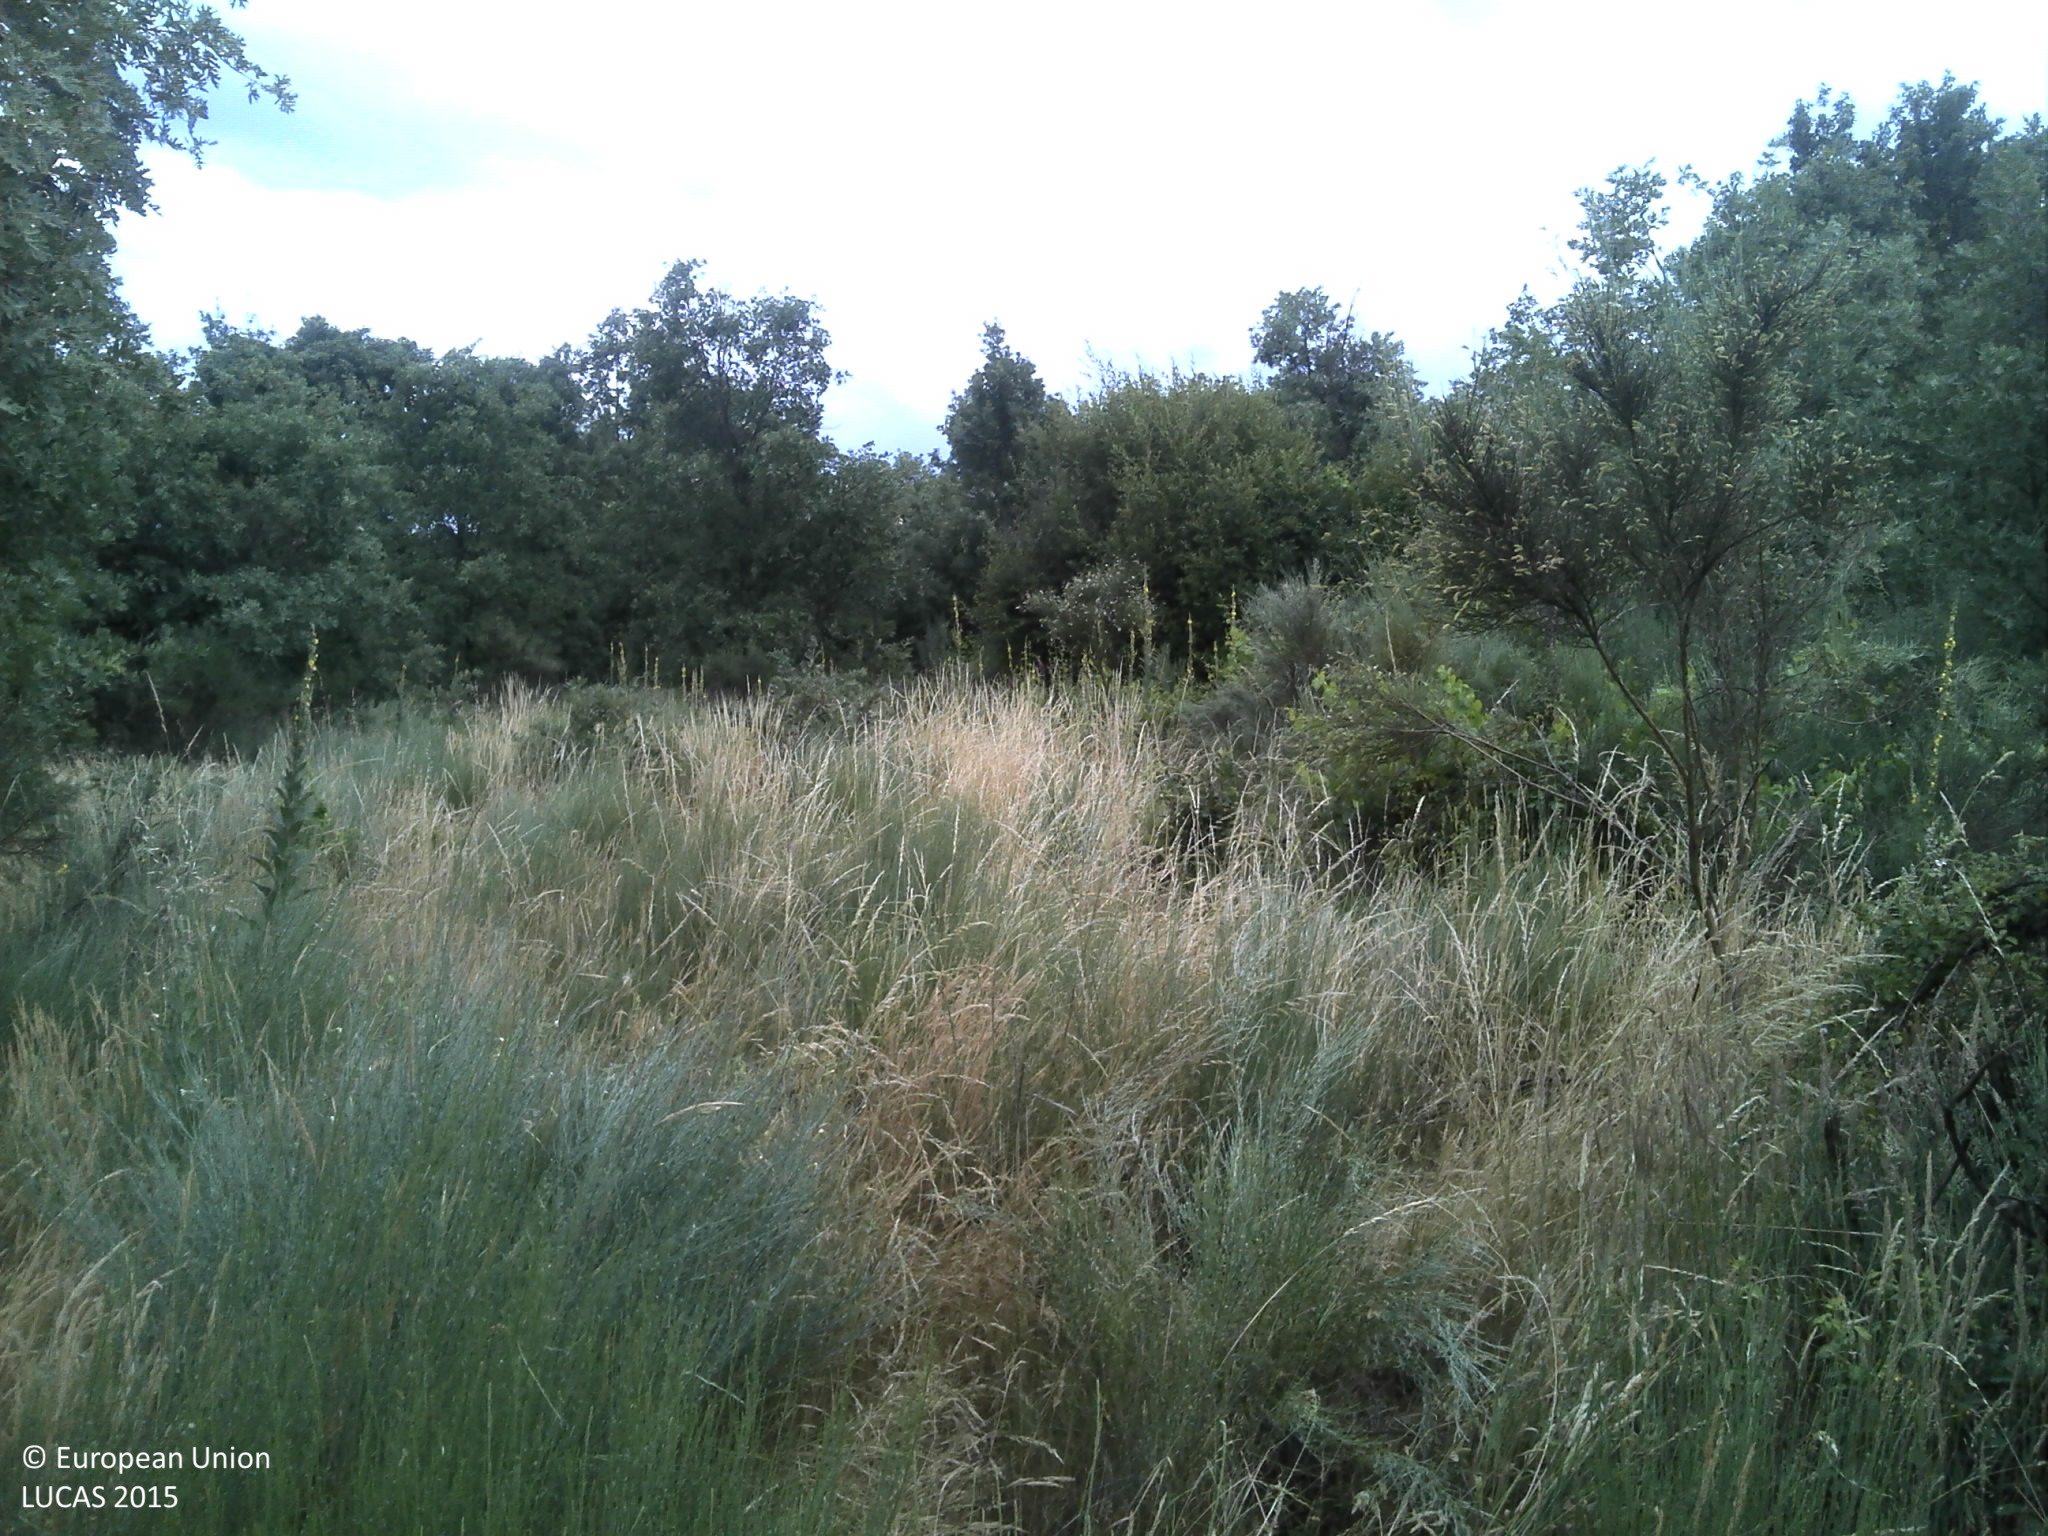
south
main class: Woodland
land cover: Broadleaved woodland
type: acidophilous oak and oak-birch forest
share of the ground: 25 - 50 %
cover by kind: broadleaved forest trees 50 %, shrubs 30 %, unconsolidated bare surface 15 %
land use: Forestry
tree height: > 5 m
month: June
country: PT
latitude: 40.2847
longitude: -7.4073
